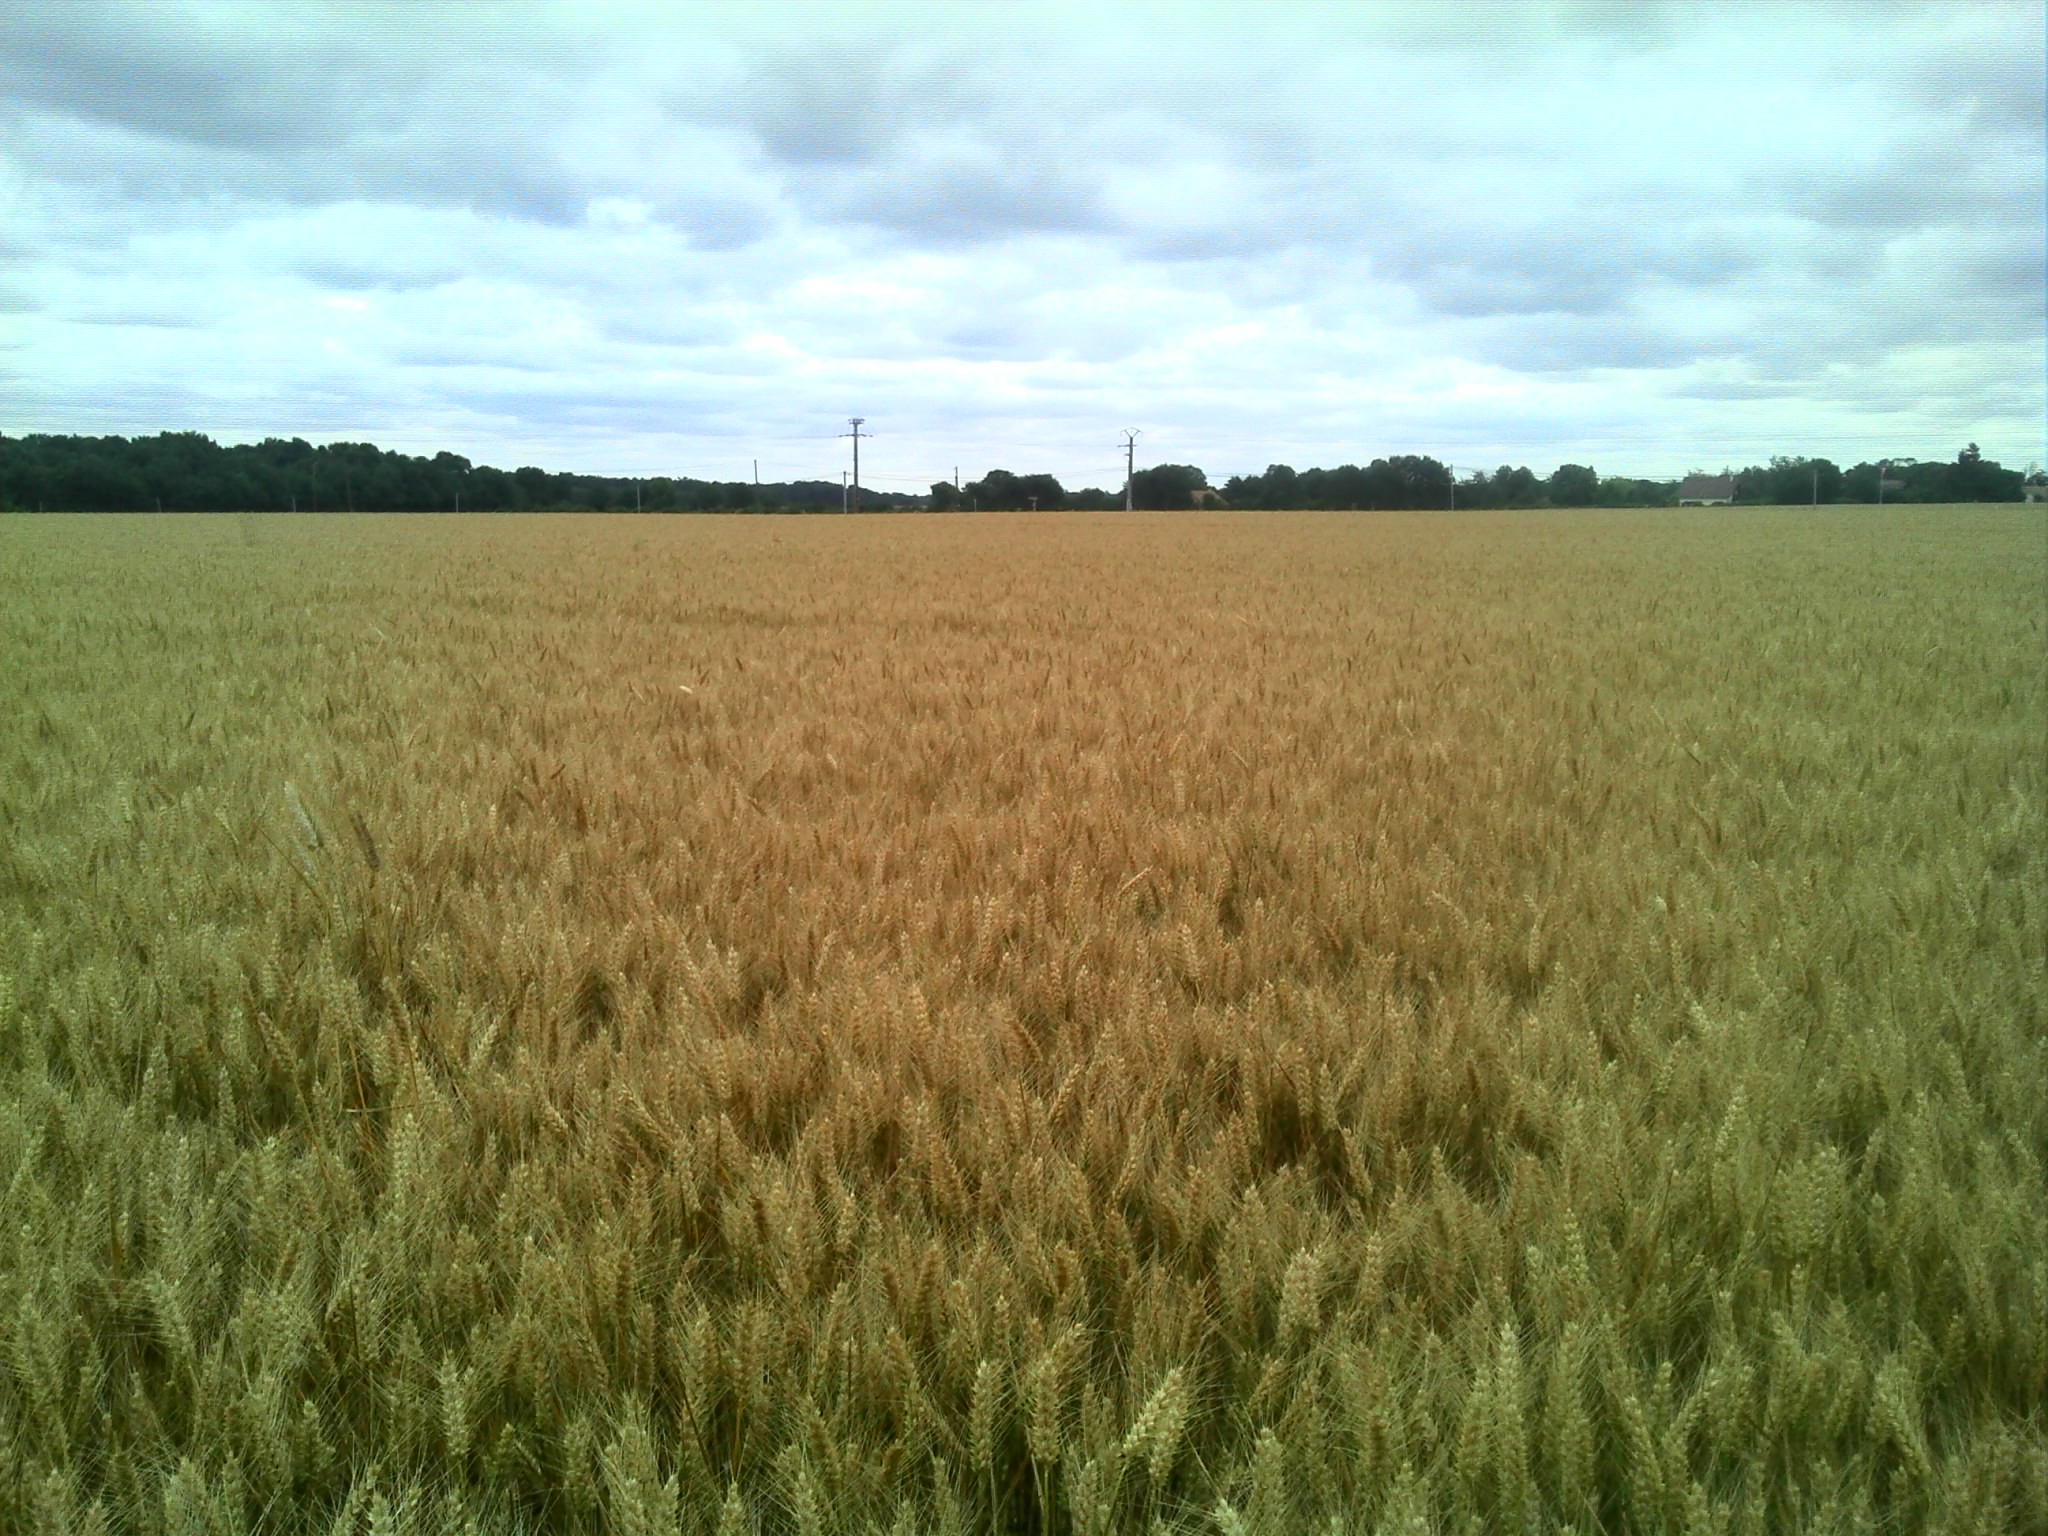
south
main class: Cropland
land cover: Common wheat
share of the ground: > 75 %
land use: Agriculture (excluding fallow land and kitchen gardens)
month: July
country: FR
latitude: 49.0085
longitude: 0.7206
